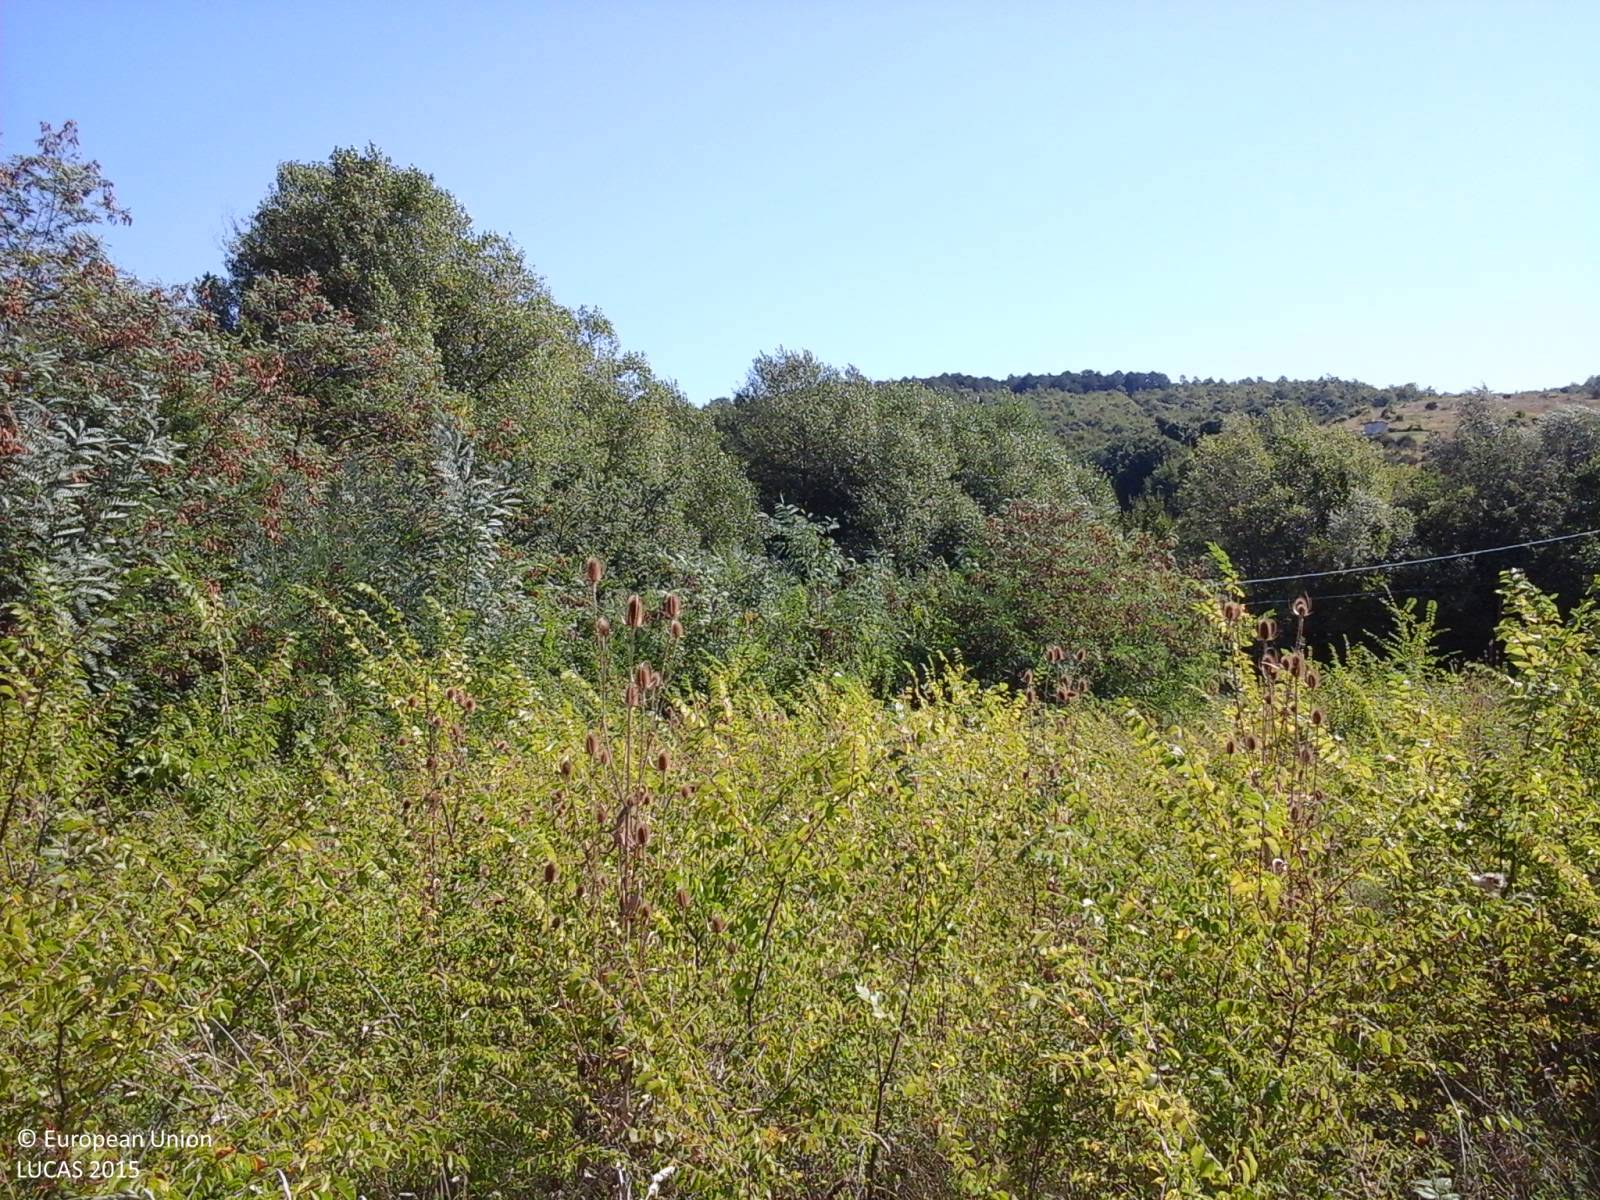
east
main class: Shrubland
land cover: Shrubland with sparse tree cover
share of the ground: 50 - 75 %
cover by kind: shrubs 55 %, herbaceous plants 40 %, broadleaved forest trees 5 %
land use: Abandoned areas
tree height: < 5 m
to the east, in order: Shrubland with sparse tree cover; Electric lines; Shrubland with sparse tree cover; Broadleaved woodland
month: September
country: IT
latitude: 43.1256
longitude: 12.6352
